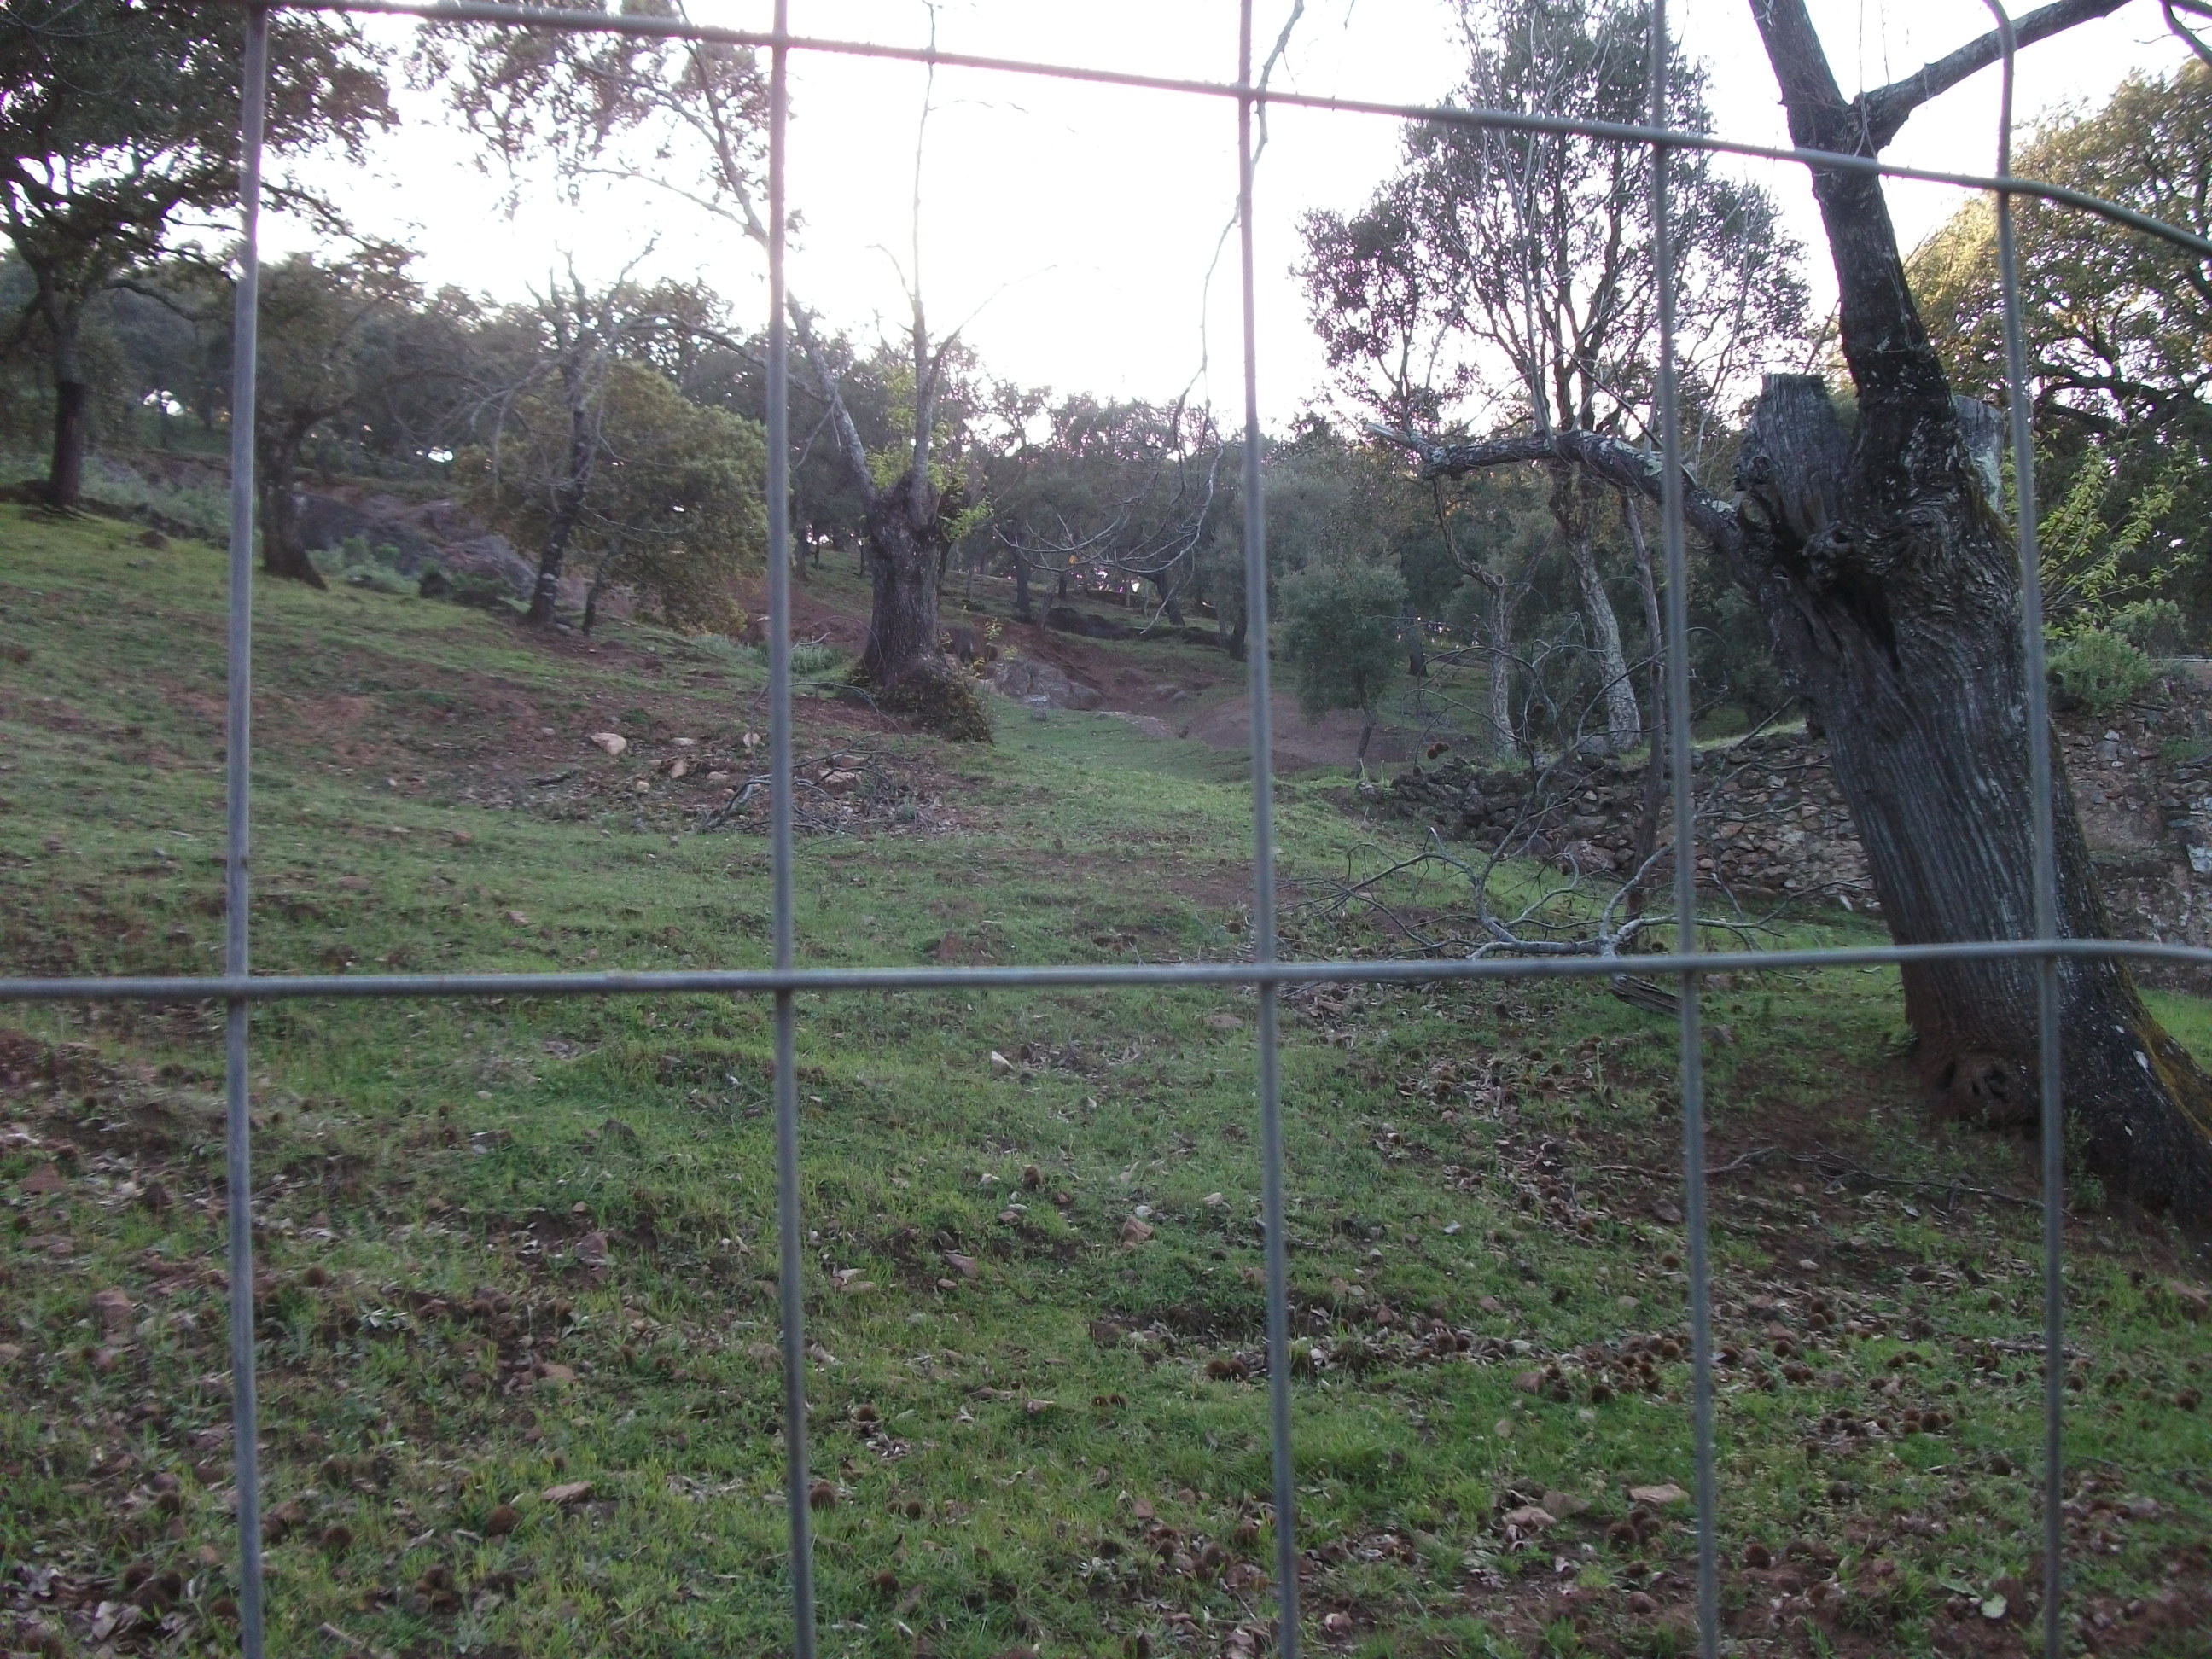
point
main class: Woodland
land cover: Broadleaved woodland
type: broadleaved evergreen forest
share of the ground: 50 - 75 %
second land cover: Grassland without tree/shrub cover
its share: > 75 %
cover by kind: broadleaved forest trees 70 %, herbaceous plants 30 %
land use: Forestry
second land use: Agriculture (excluding fallow land and kitchen gardens)
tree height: > 5 m
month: April
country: ES
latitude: 37.8619
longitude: -6.7207
